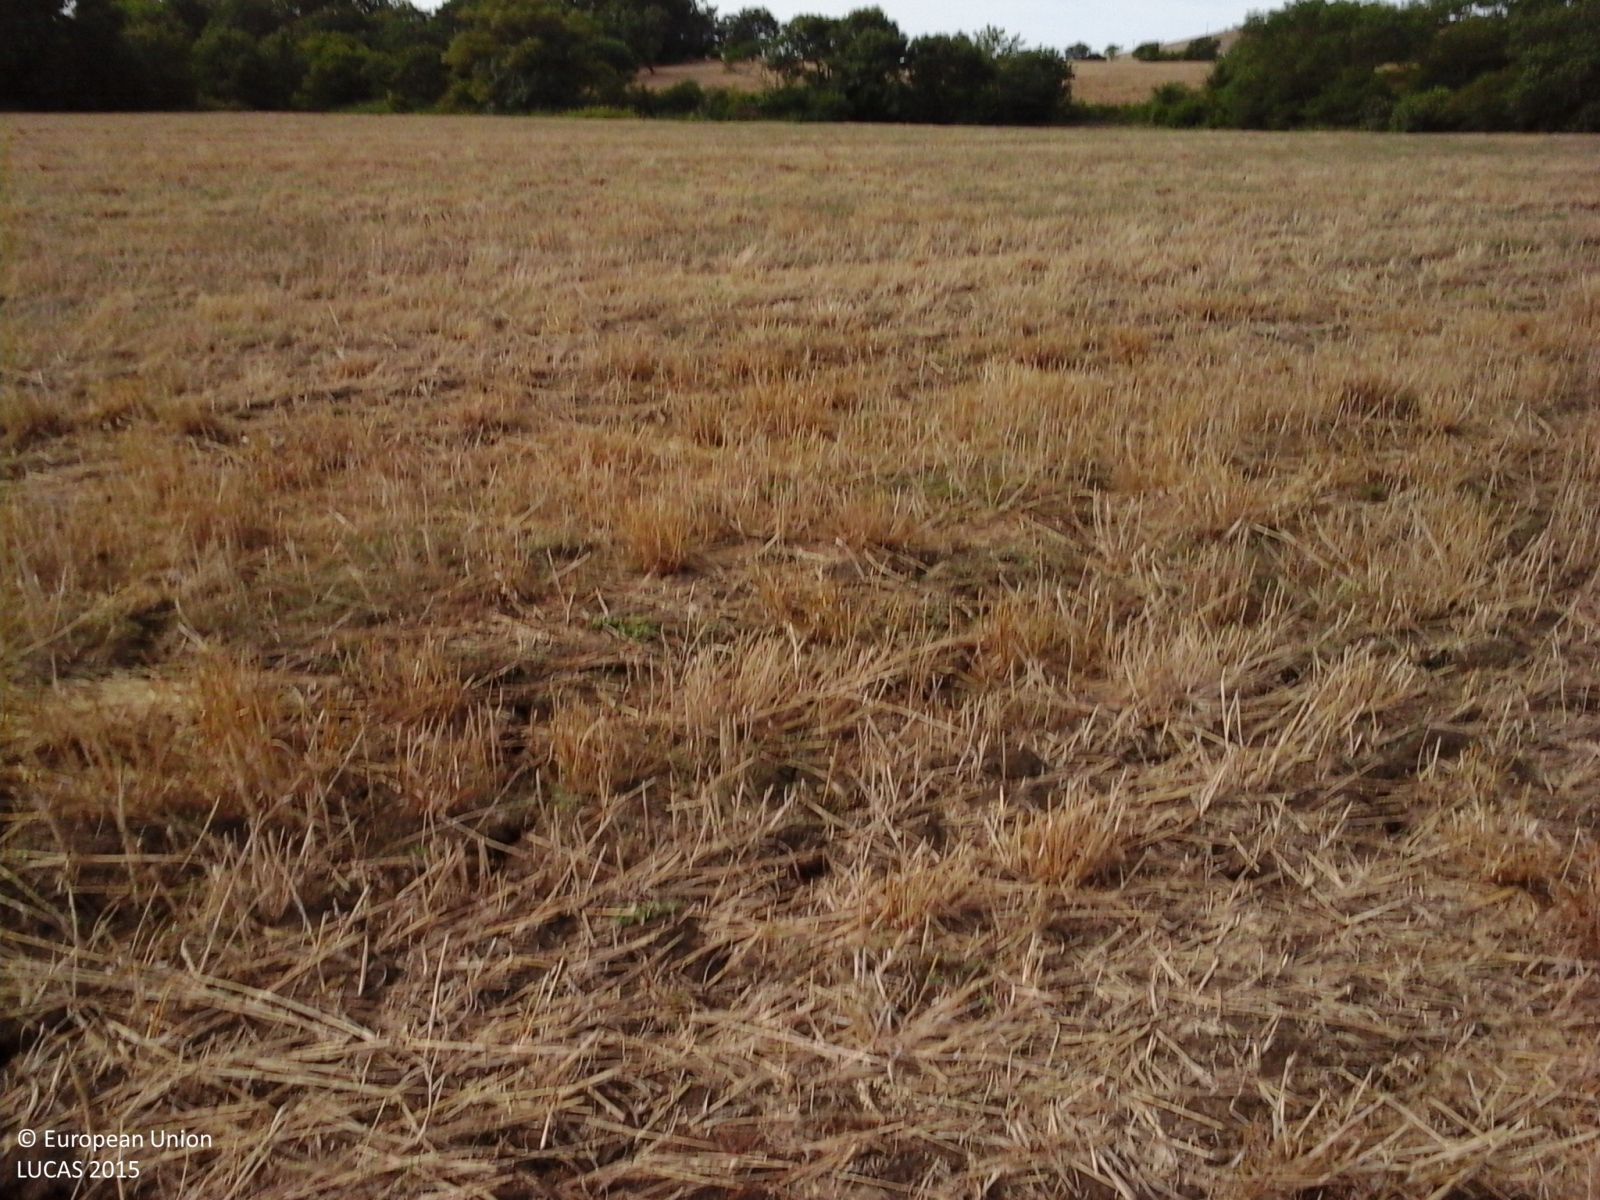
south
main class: Cropland
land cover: Durum wheat
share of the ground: > 75 %
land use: Agriculture (excluding fallow land and kitchen gardens)
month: August
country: IT
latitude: 42.5715
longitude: 11.4448
